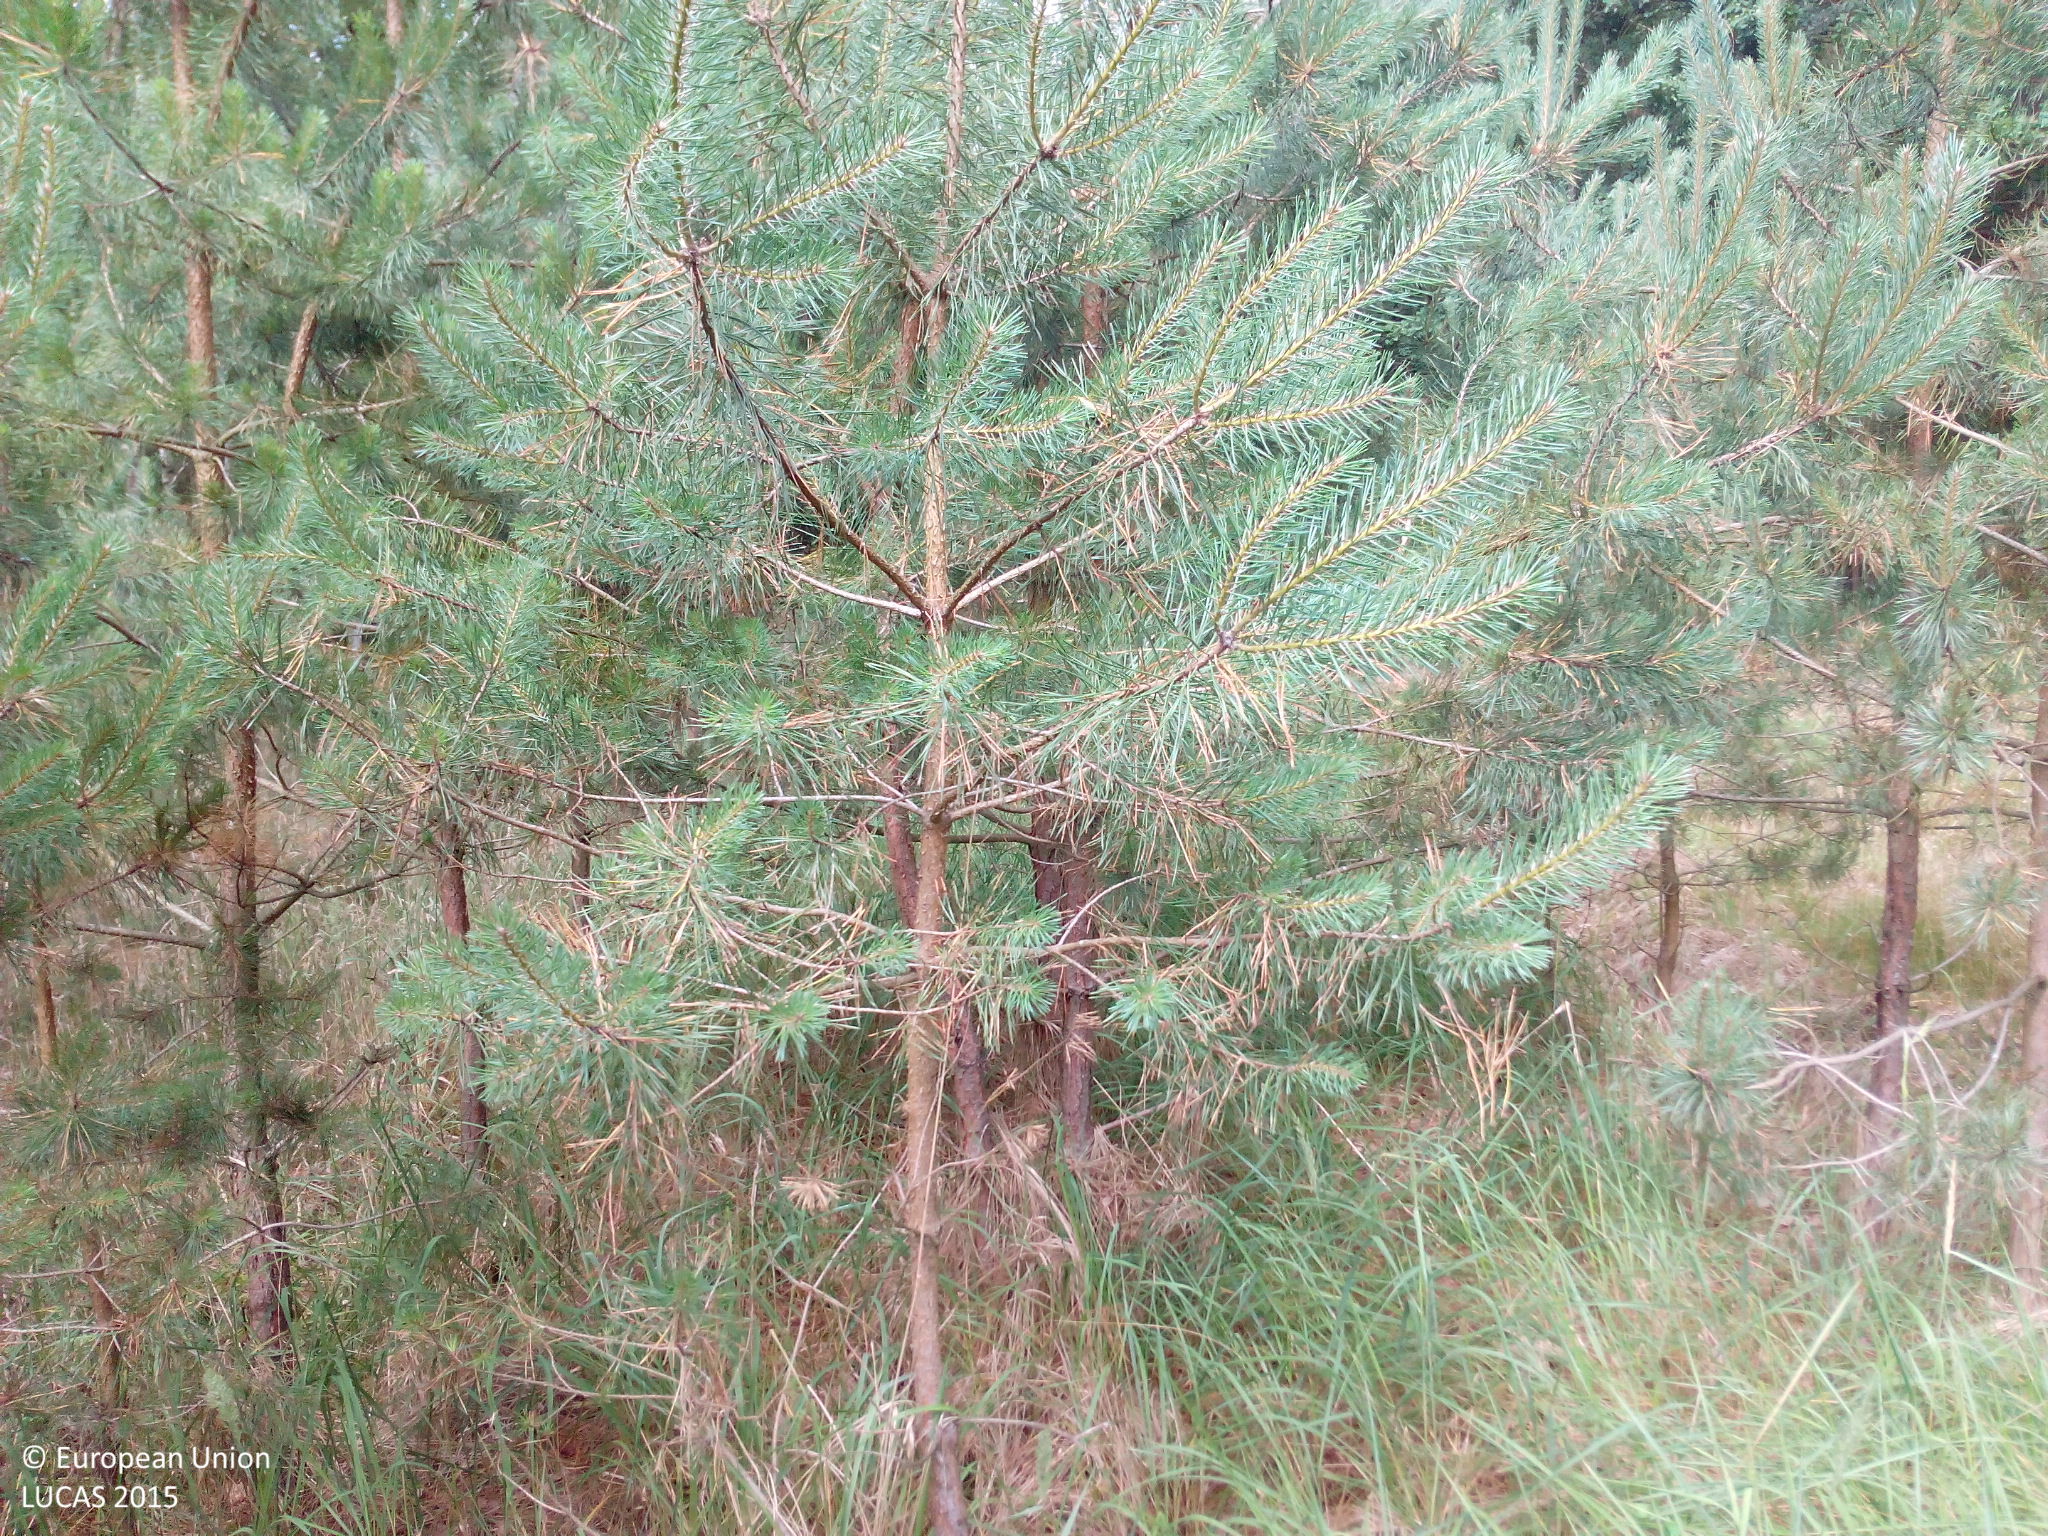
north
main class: Woodland
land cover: Pine dominated coniferous woodland
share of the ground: 50 - 75 %
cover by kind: coniferous forest trees 50 %, herbaceous plants 50 %
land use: Forestry
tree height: < 5 m
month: July
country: DE
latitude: 52.8760
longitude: 12.3322
